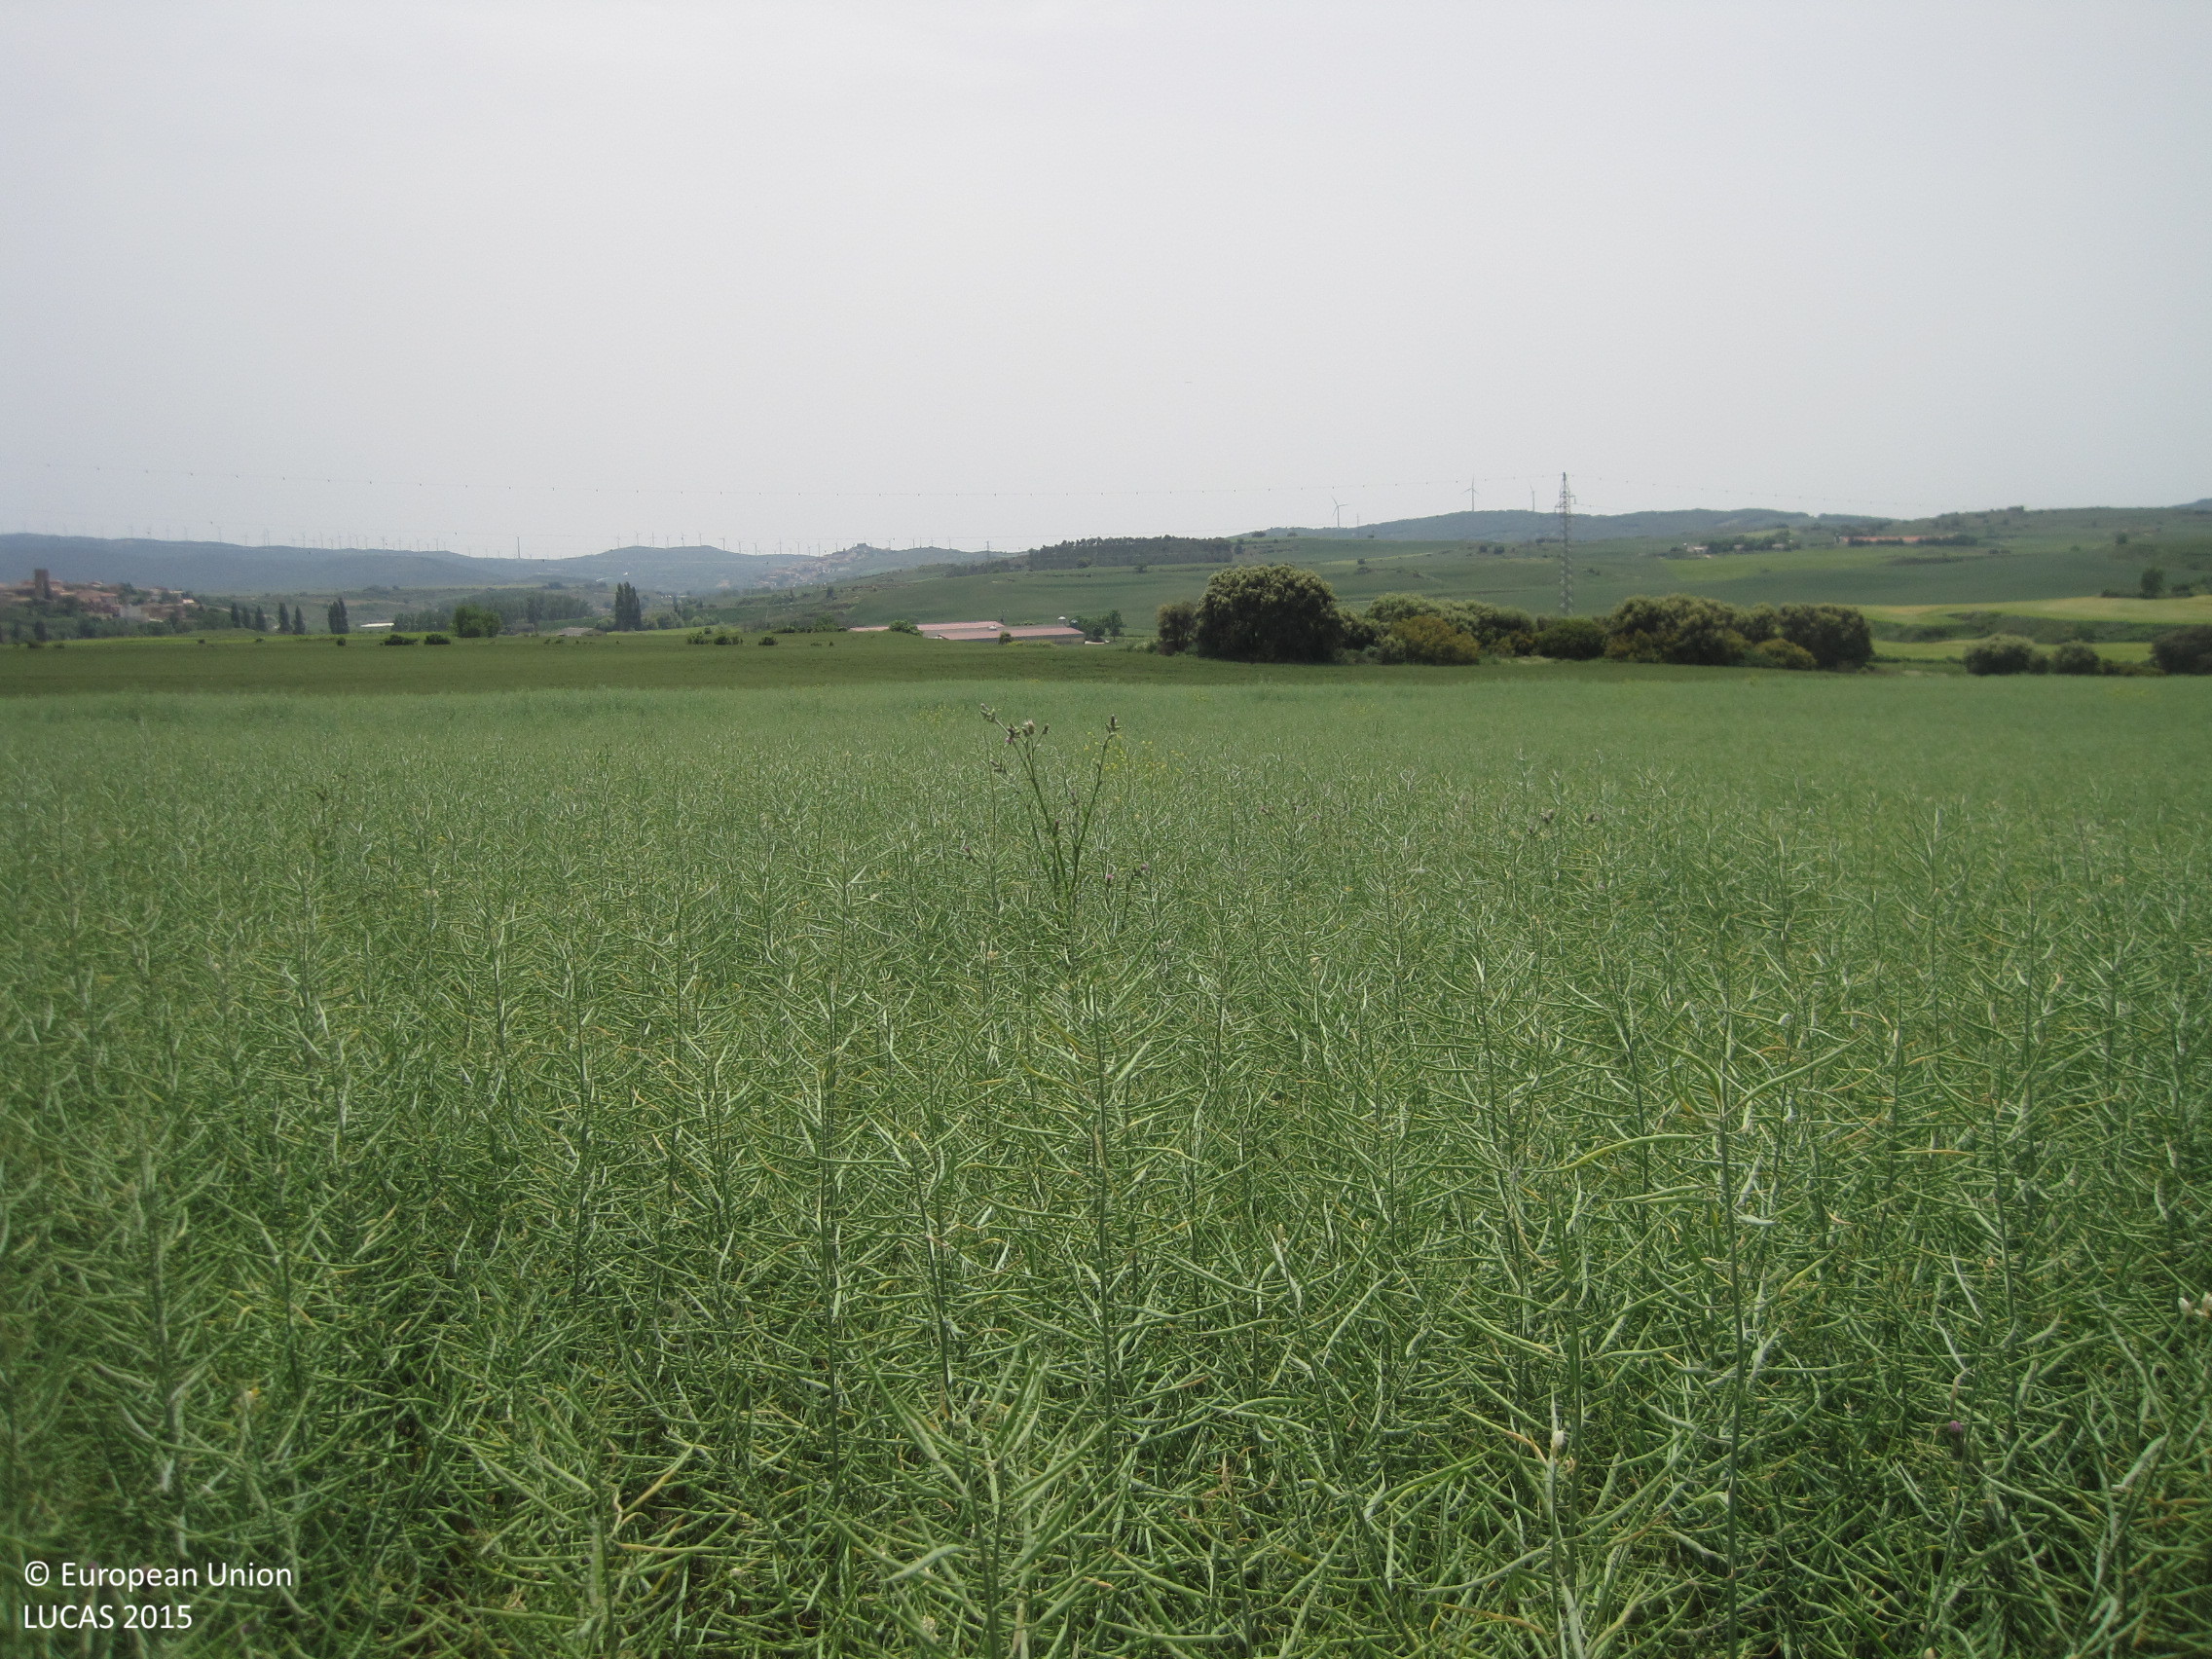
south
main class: Cropland
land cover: Rape and turnip rape
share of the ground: > 75 %
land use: Agriculture (excluding fallow land and kitchen gardens)
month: May
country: ES
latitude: 42.6166
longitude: -1.6557
